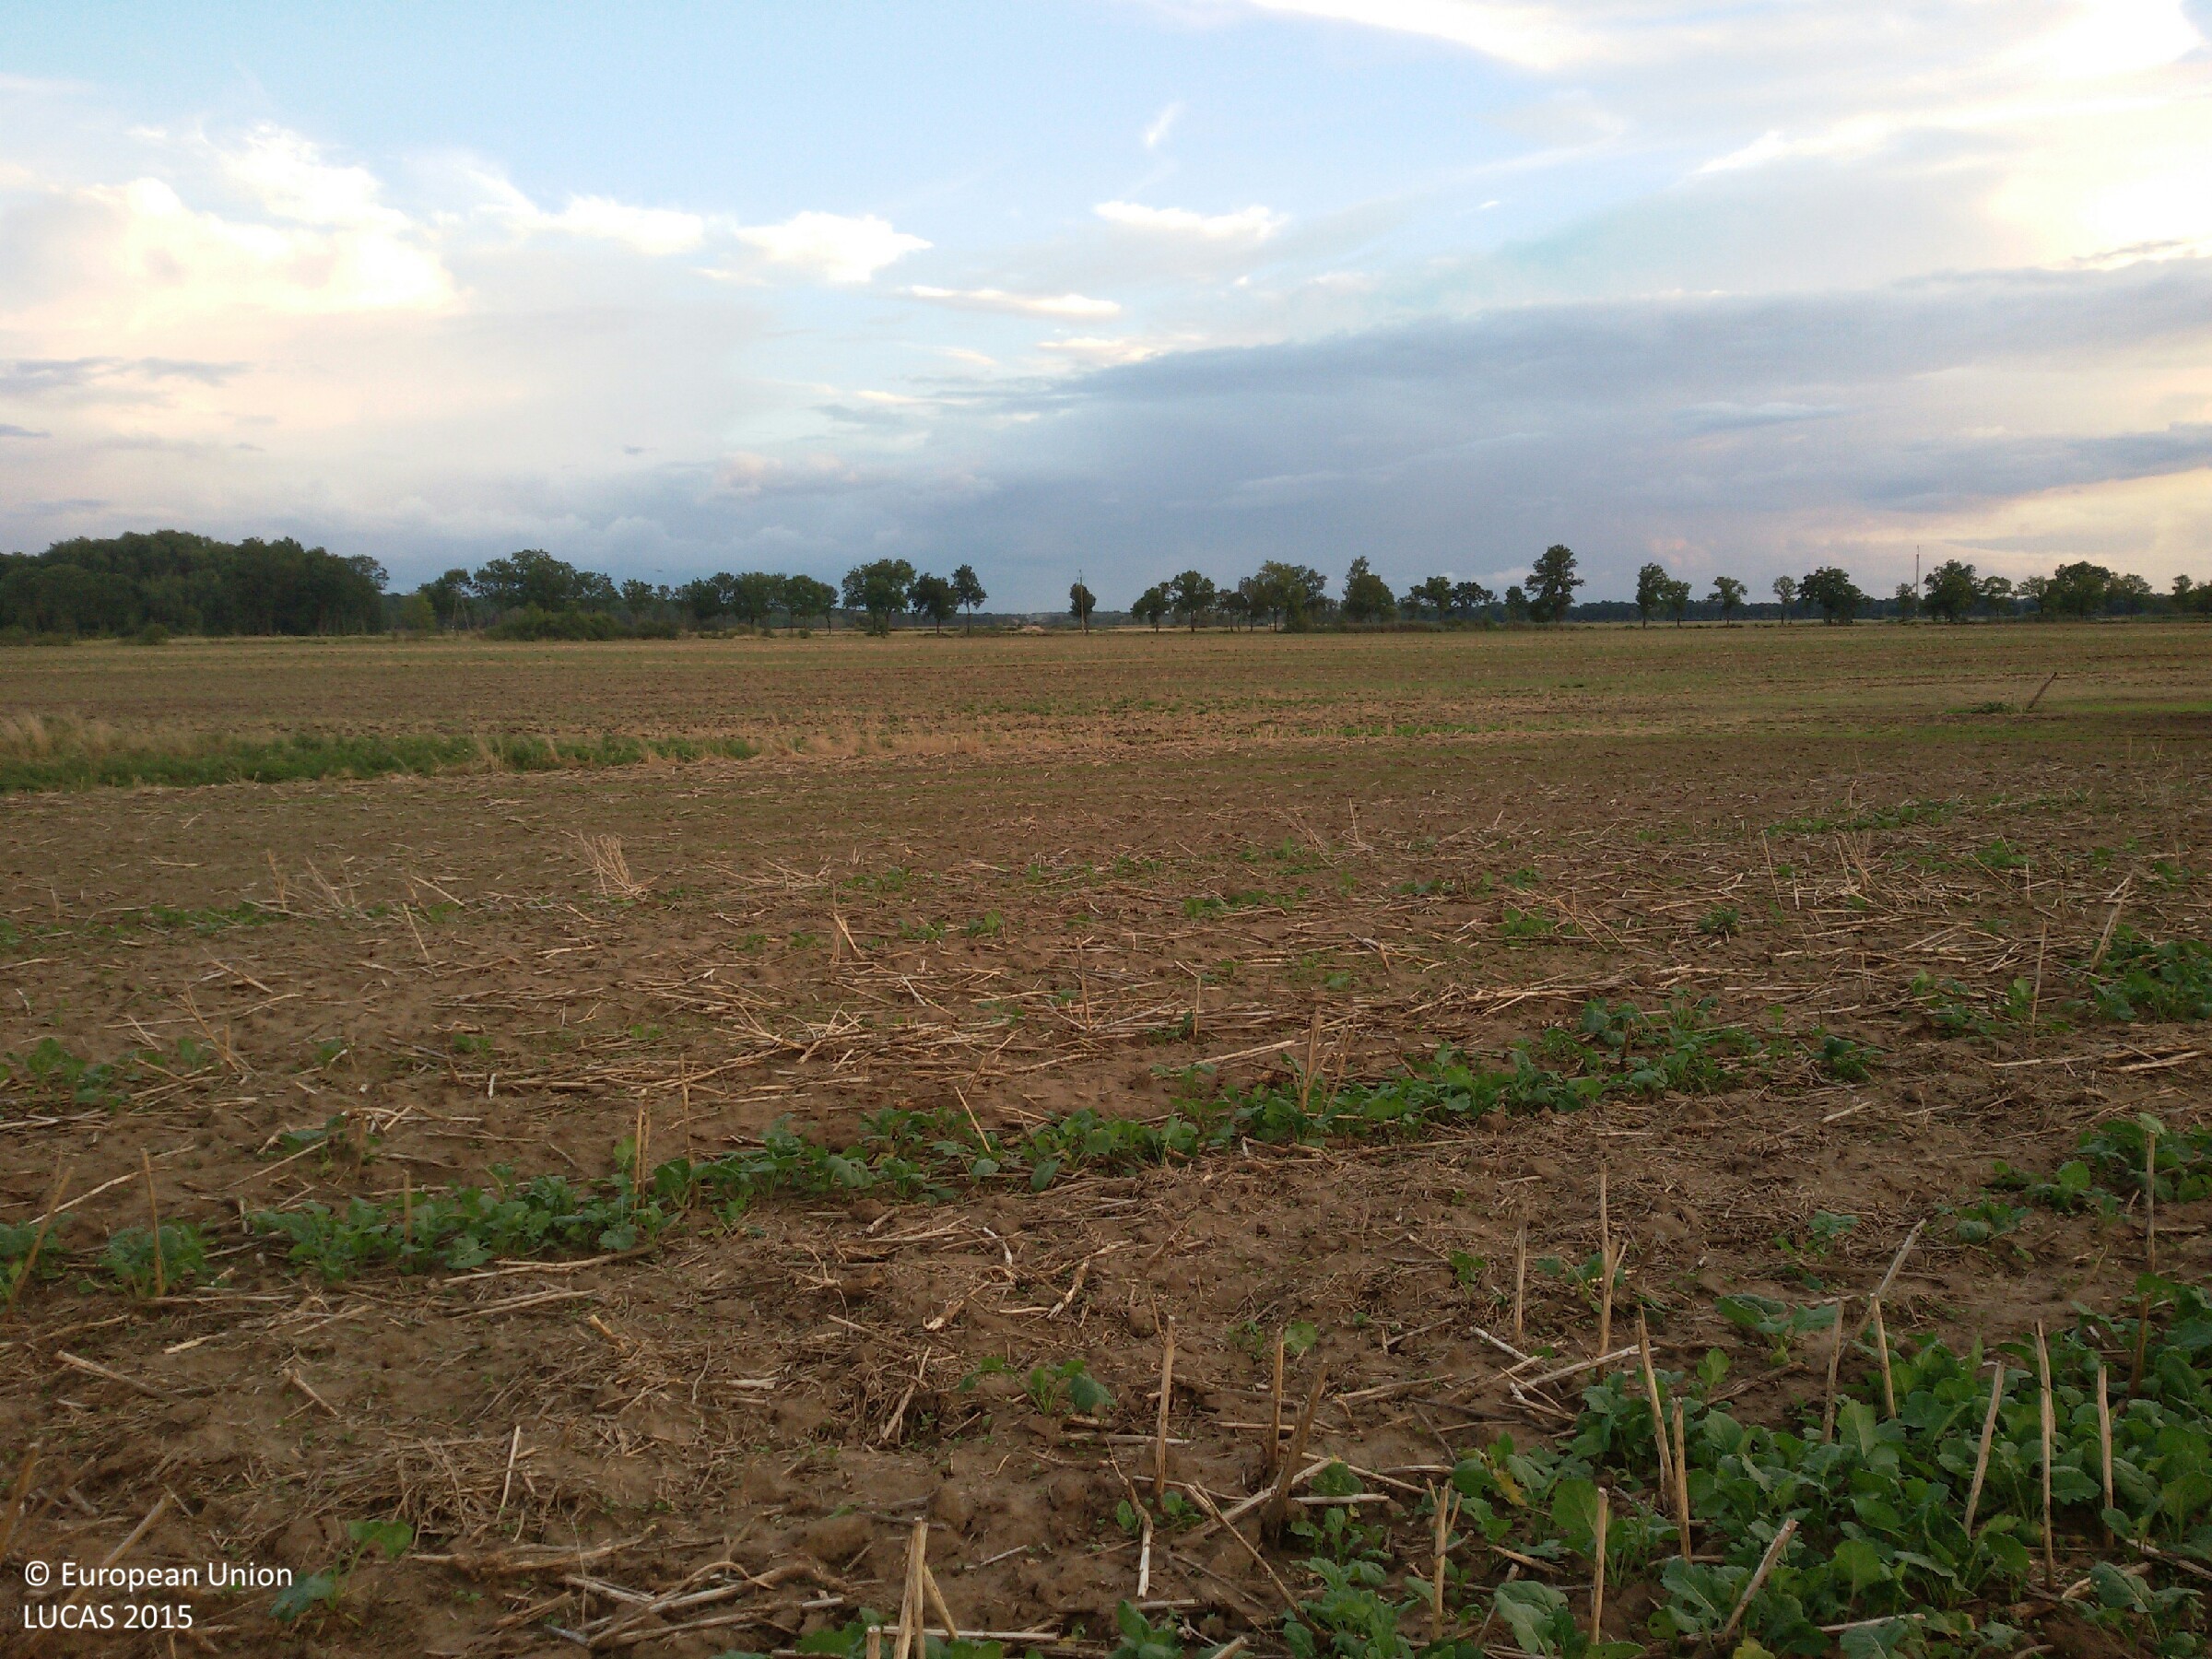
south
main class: Cropland
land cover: Rape and turnip rape
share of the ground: 10 - 25 %
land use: Agriculture (excluding fallow land and kitchen gardens)
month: September
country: PL
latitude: 52.1396
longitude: 14.7216
